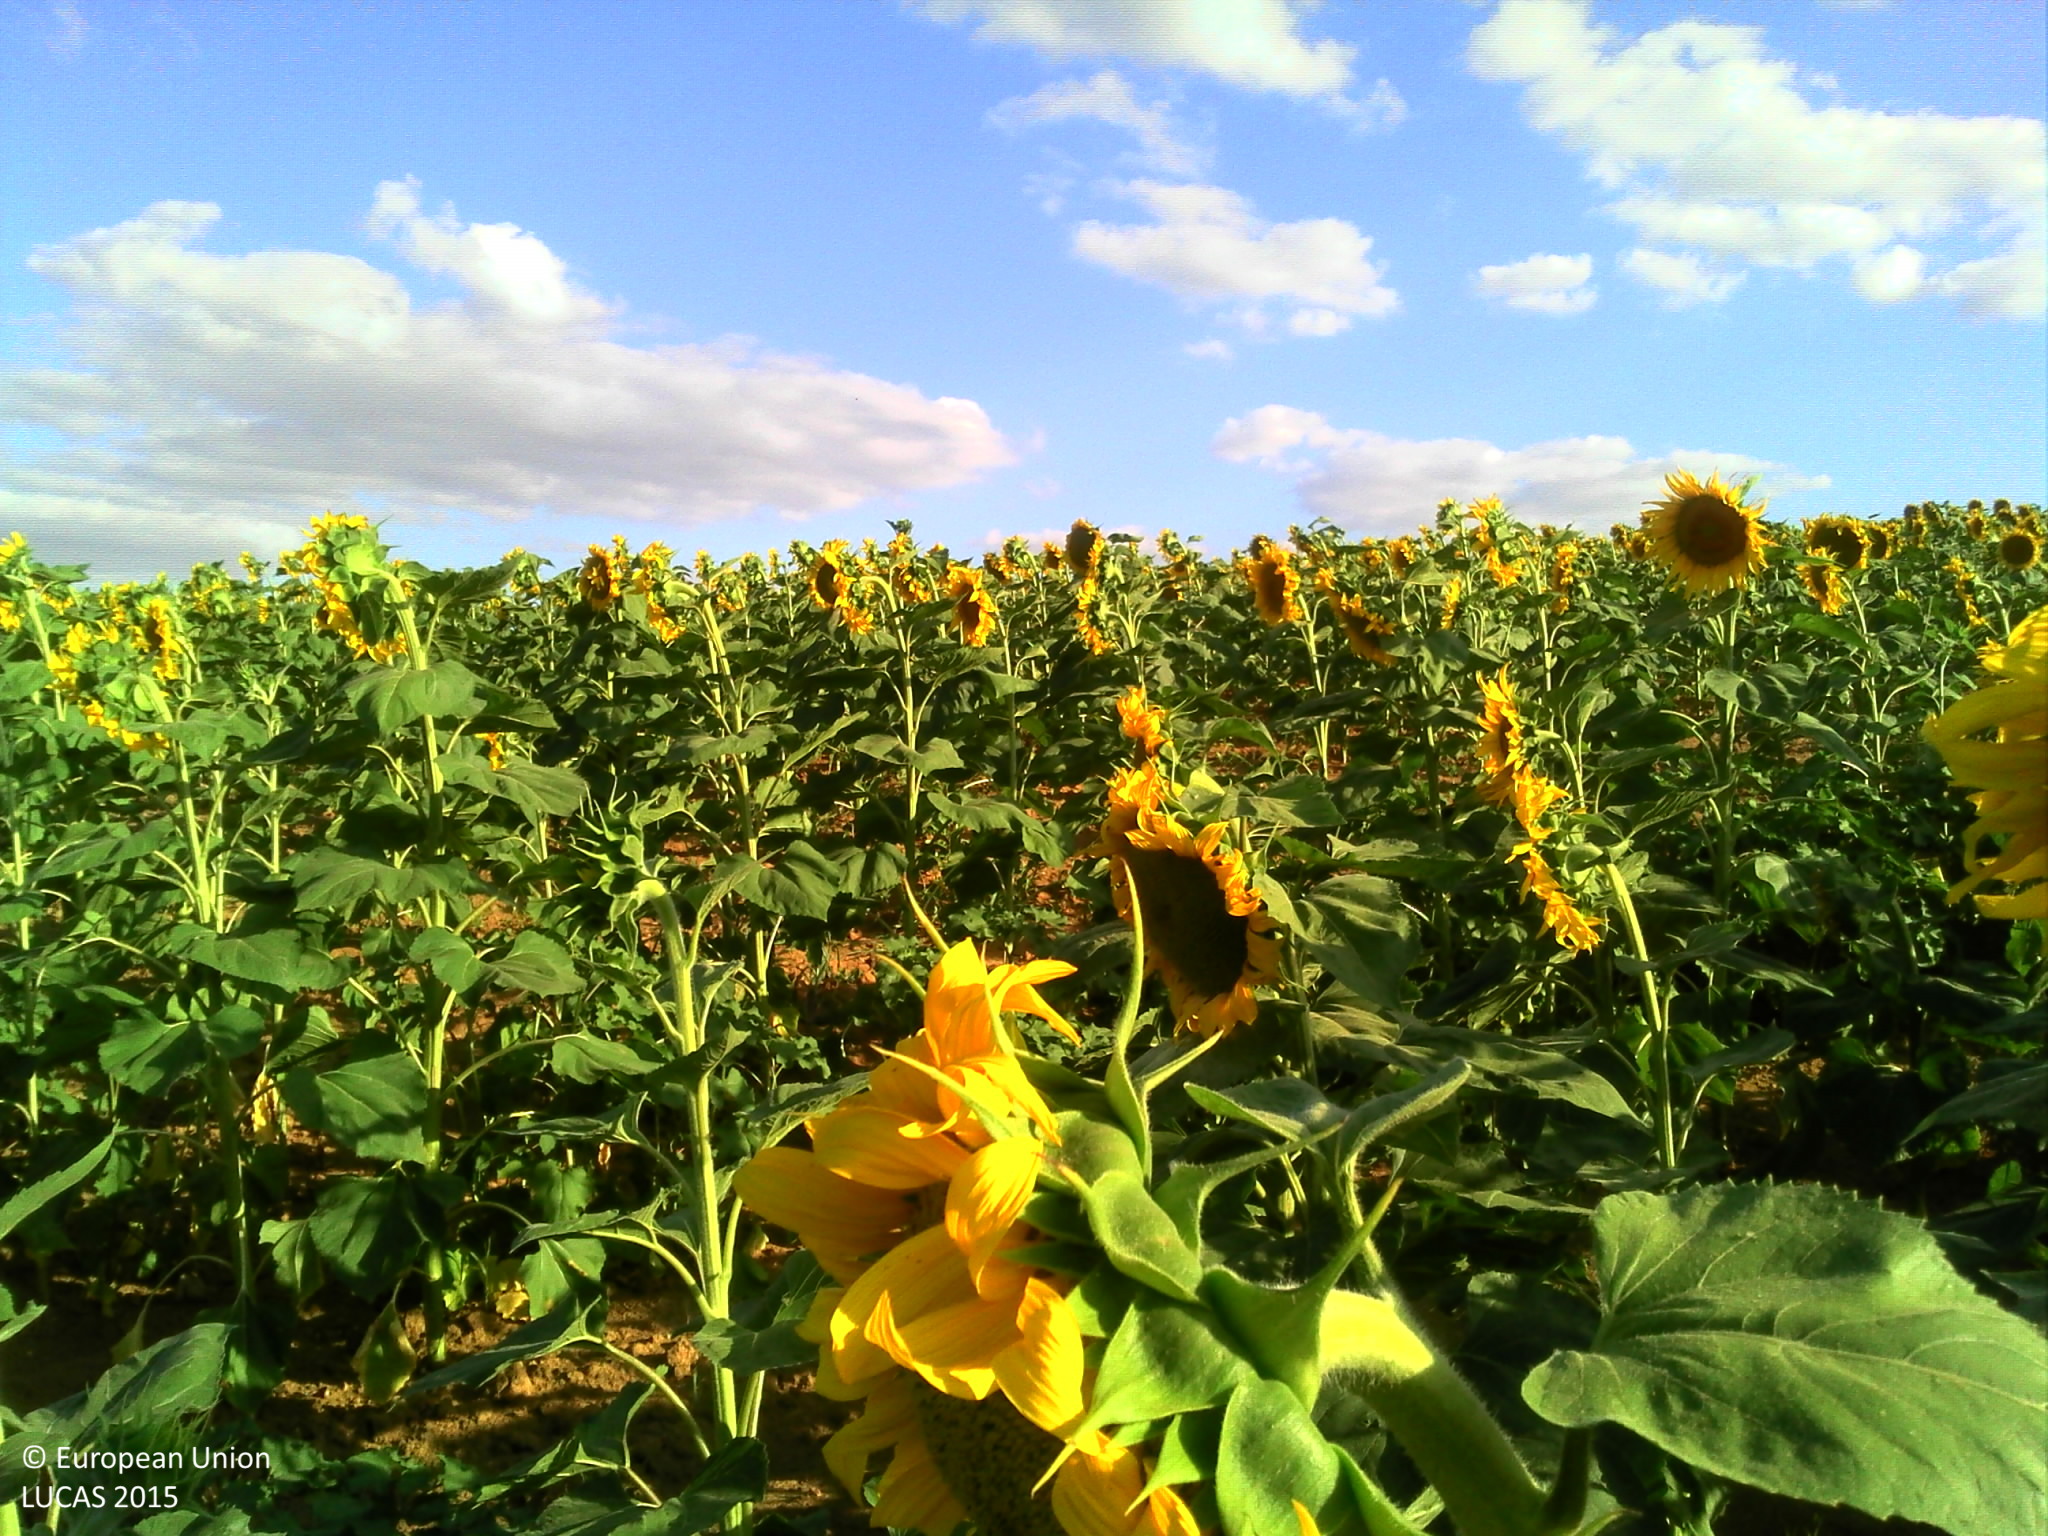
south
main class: Cropland
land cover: Sunflower
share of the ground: > 75 %
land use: Agriculture (excluding fallow land and kitchen gardens)
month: July
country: FR
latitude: 43.8596
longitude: 0.9036
